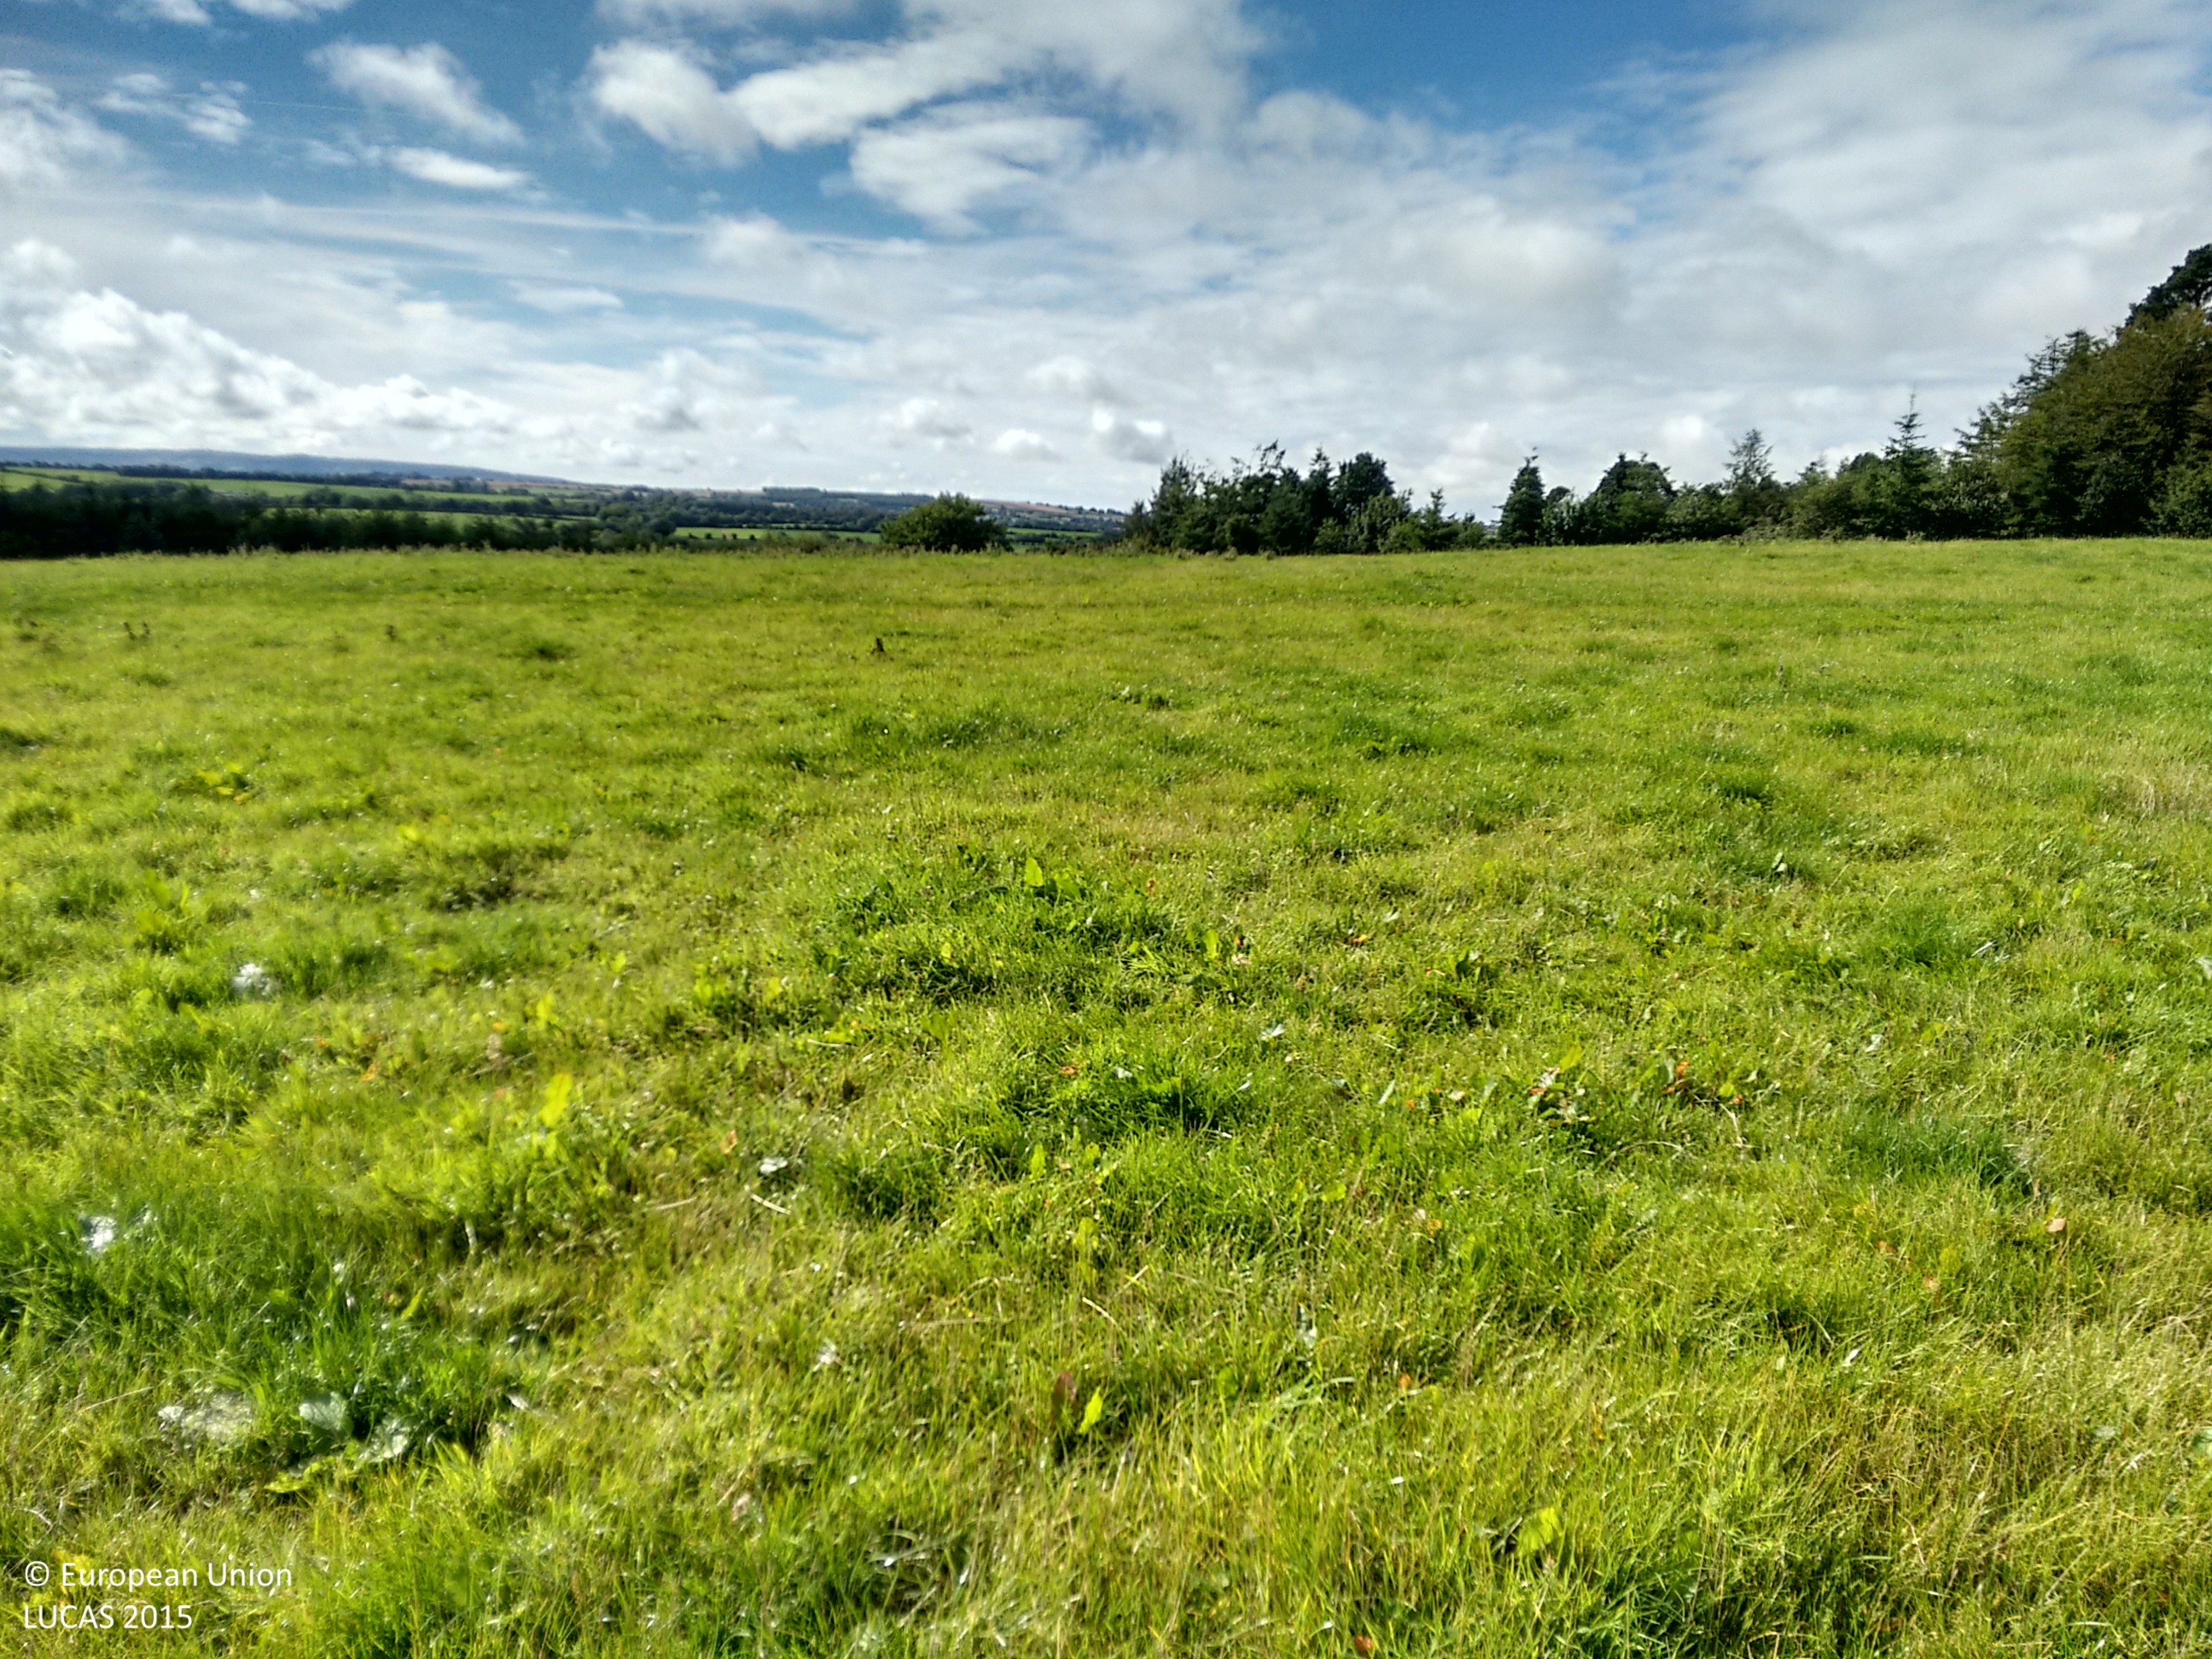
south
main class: Grassland
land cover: Grassland without tree/shrub cover
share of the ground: > 75 %
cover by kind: herbaceous plants 100 %
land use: Agriculture (excluding fallow land and kitchen gardens)
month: August
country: IE
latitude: 52.4216
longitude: -6.6454
